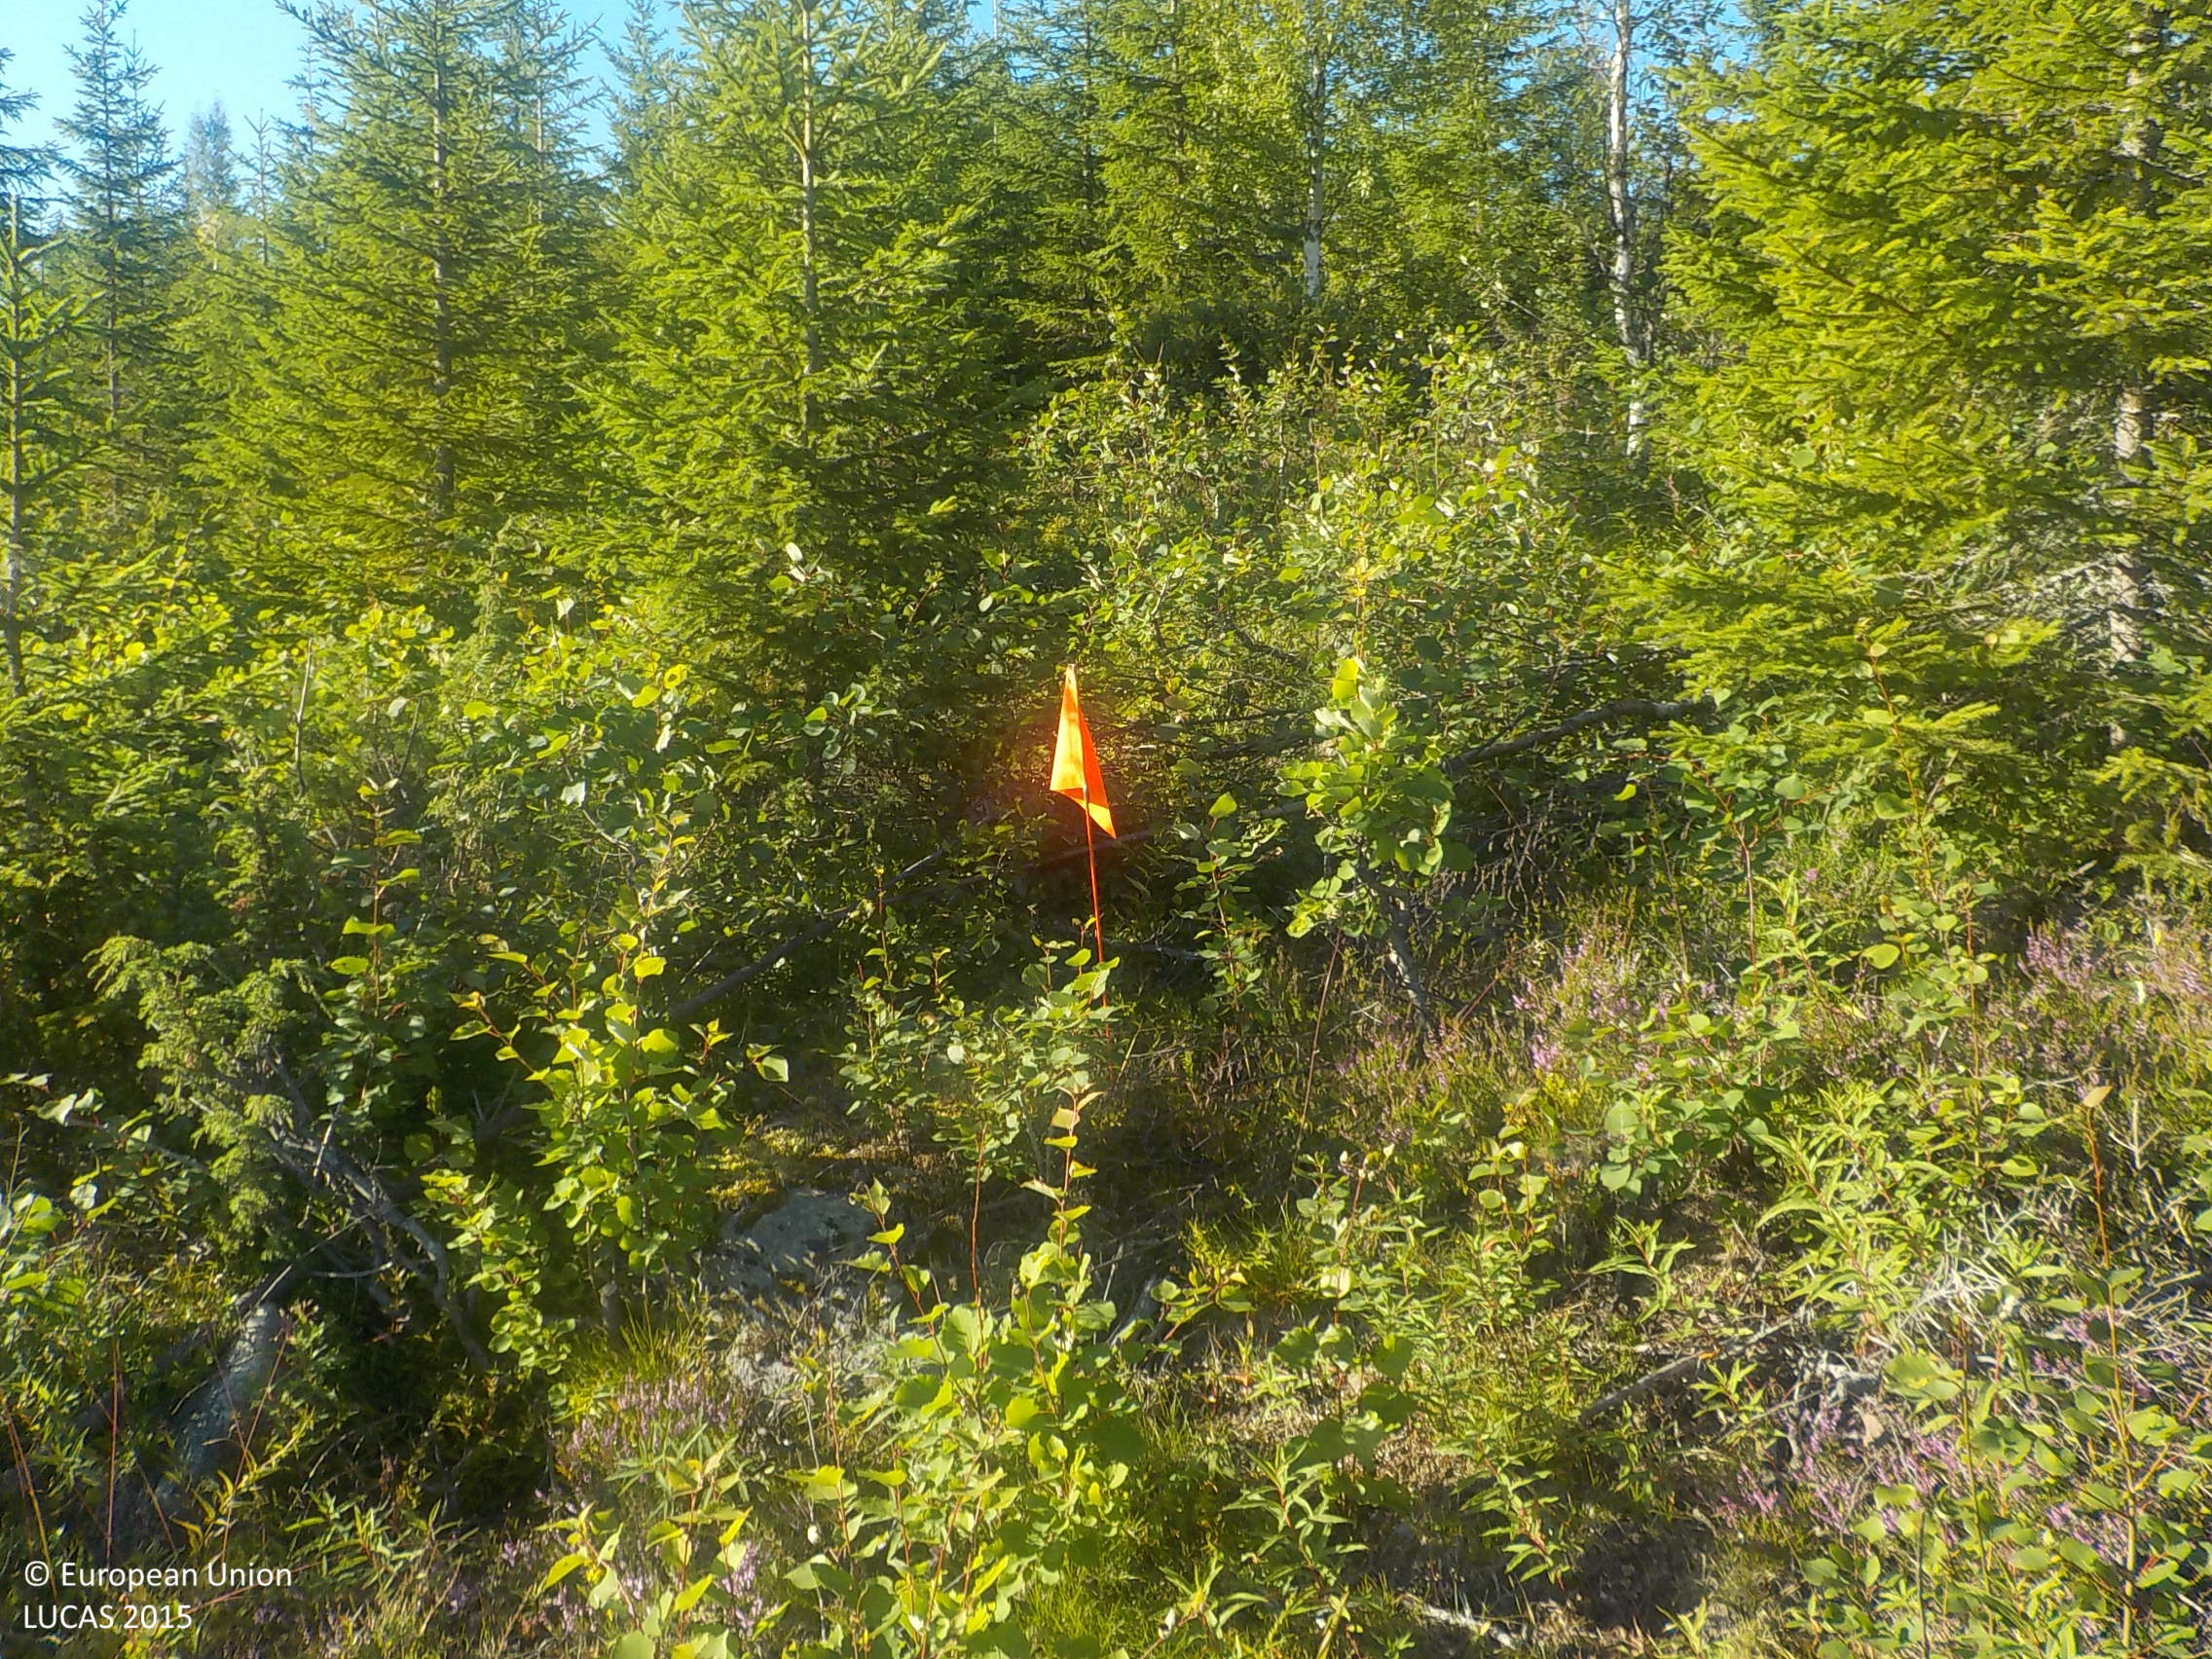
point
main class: Woodland
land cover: Spruce dominated mixed woodland
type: boreal forest
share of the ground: 50 - 75 %
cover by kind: coniferous forest trees 45 %, shrubs 25 %, broadleaved forest trees 20 %, herbaceous plants 10 %
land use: Forestry
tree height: < 5 m
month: August
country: SE
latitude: 63.6657
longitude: 18.0759
